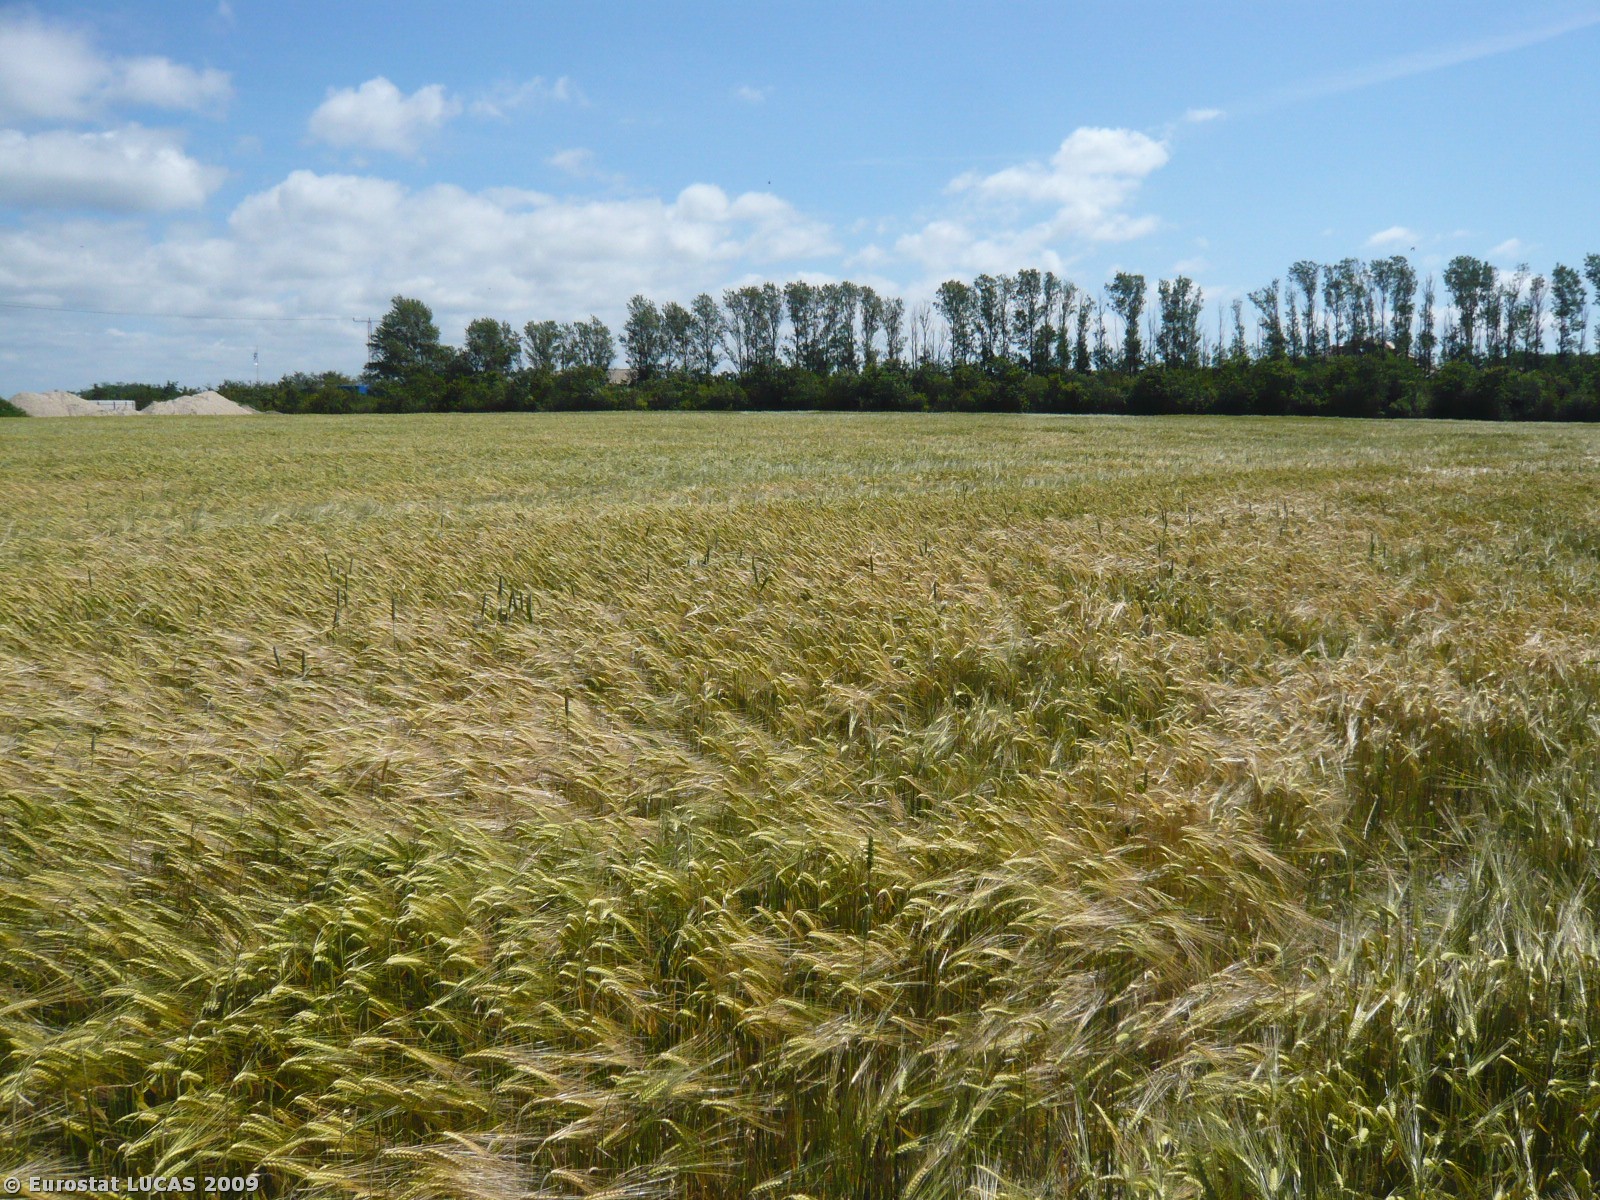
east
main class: Cropland
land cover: Barley
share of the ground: 50 - 75 %
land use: Agriculture (excluding fallow land and kitchen gardens)
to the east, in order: Barley; Bare land; Barley; Broadleaved woodland; Ditches and canals; Grass margins; Paved roads, cycling and walking lanes; Grass margins; Ditches and canals; Grass margins; Fences; Broadleaved woodland; Artificial constructions in urban areas
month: June
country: DK
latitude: 54.7069
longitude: 11.3183
